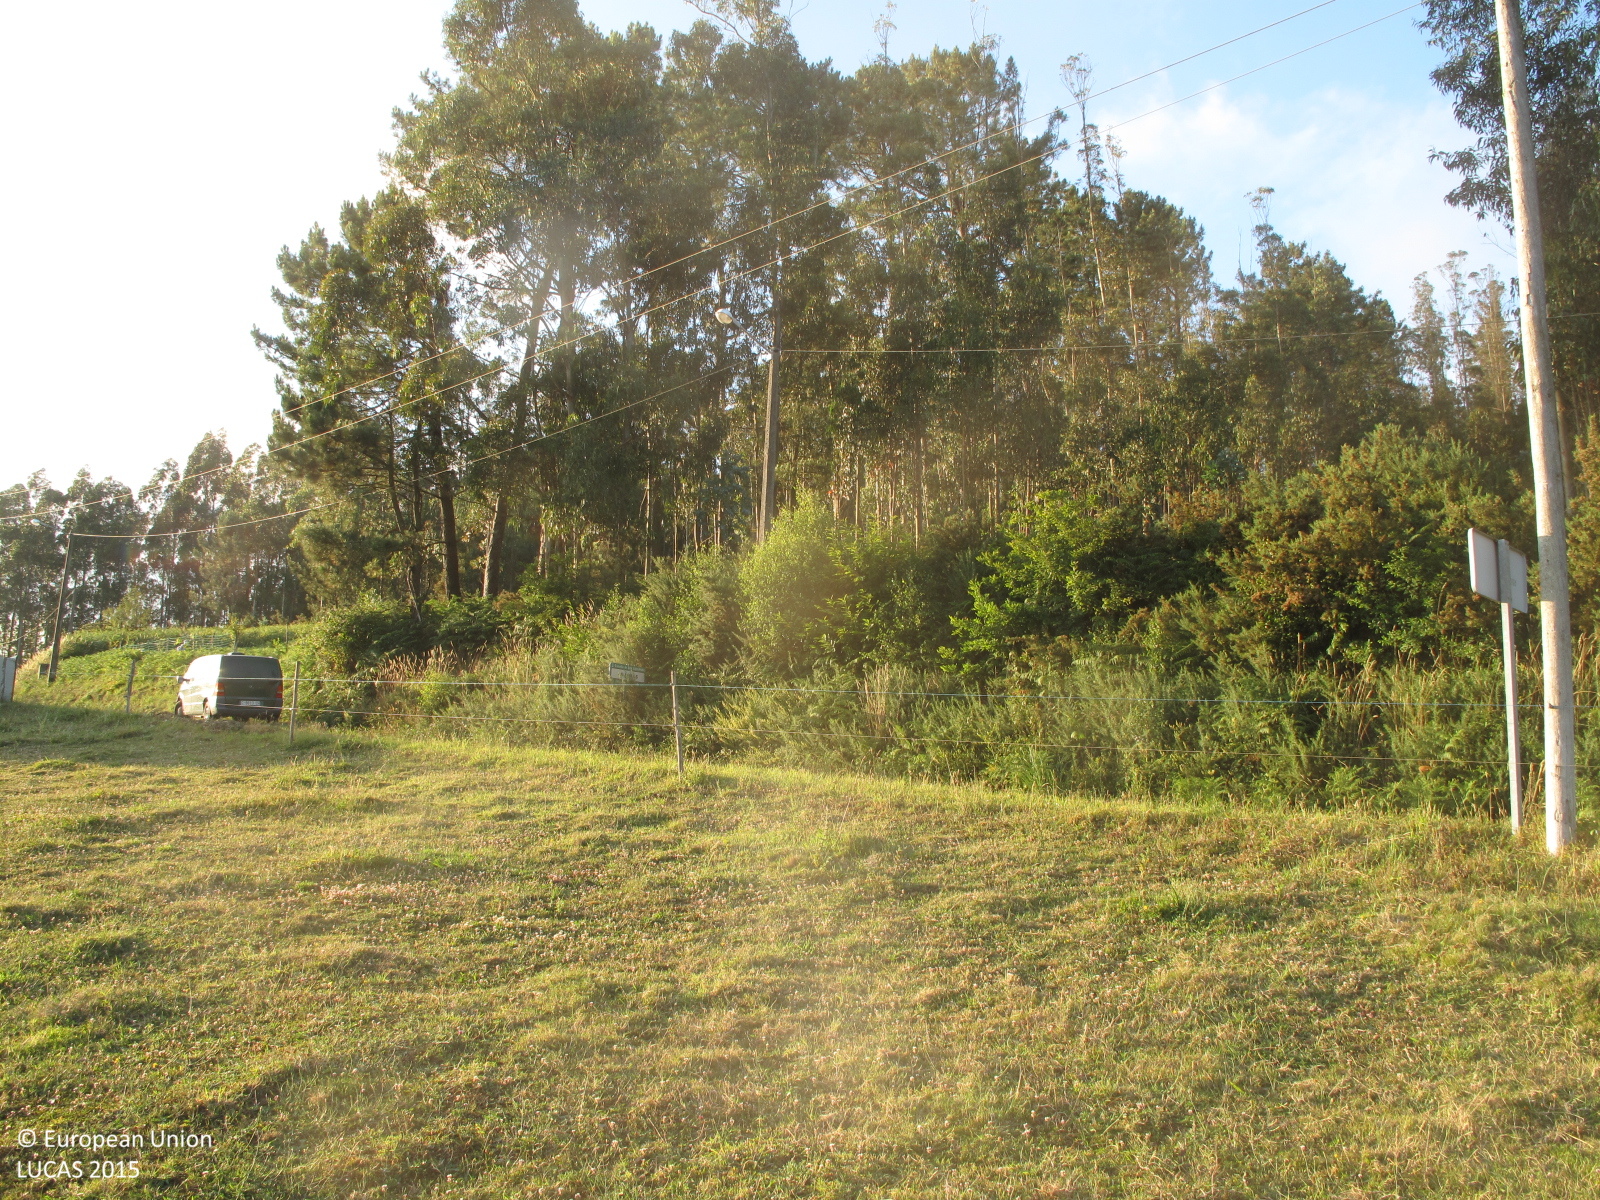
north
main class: Grassland
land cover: Grassland without tree/shrub cover
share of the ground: > 75 %
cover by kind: herbaceous plants 100 %
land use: Agriculture (excluding fallow land and kitchen gardens)
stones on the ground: 10 - 25 %
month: July
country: ES
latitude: 43.5611
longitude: -8.0620
